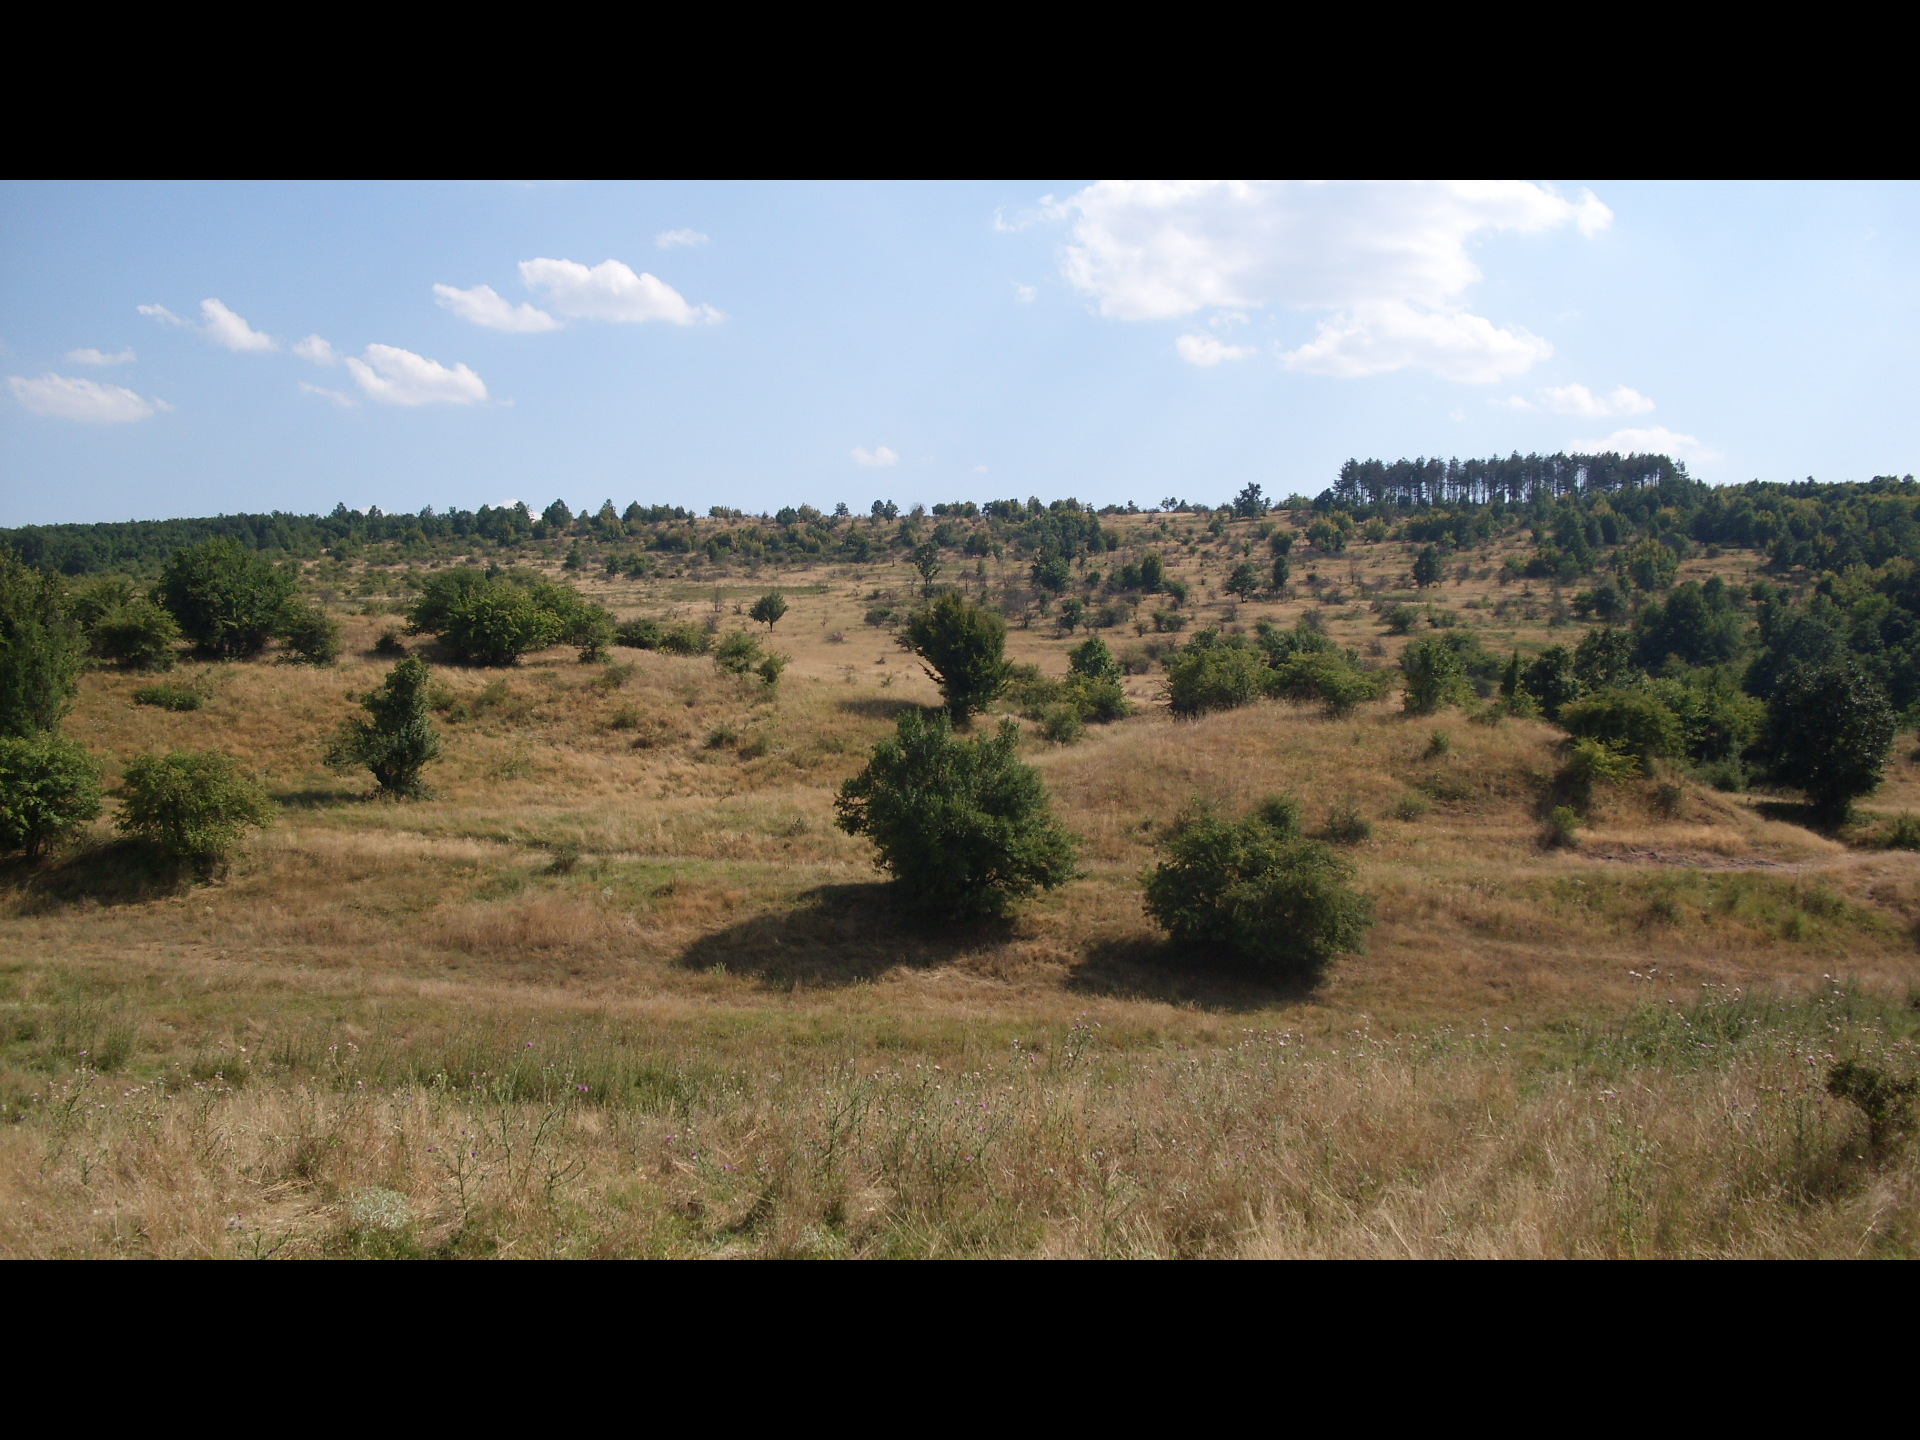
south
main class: Grassland
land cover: Grassland without tree/shrub cover
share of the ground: > 75 %
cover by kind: herbaceous plants 100 %
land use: Agriculture (excluding fallow land and kitchen gardens)
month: August
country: BG
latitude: 43.5476
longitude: 22.9965
